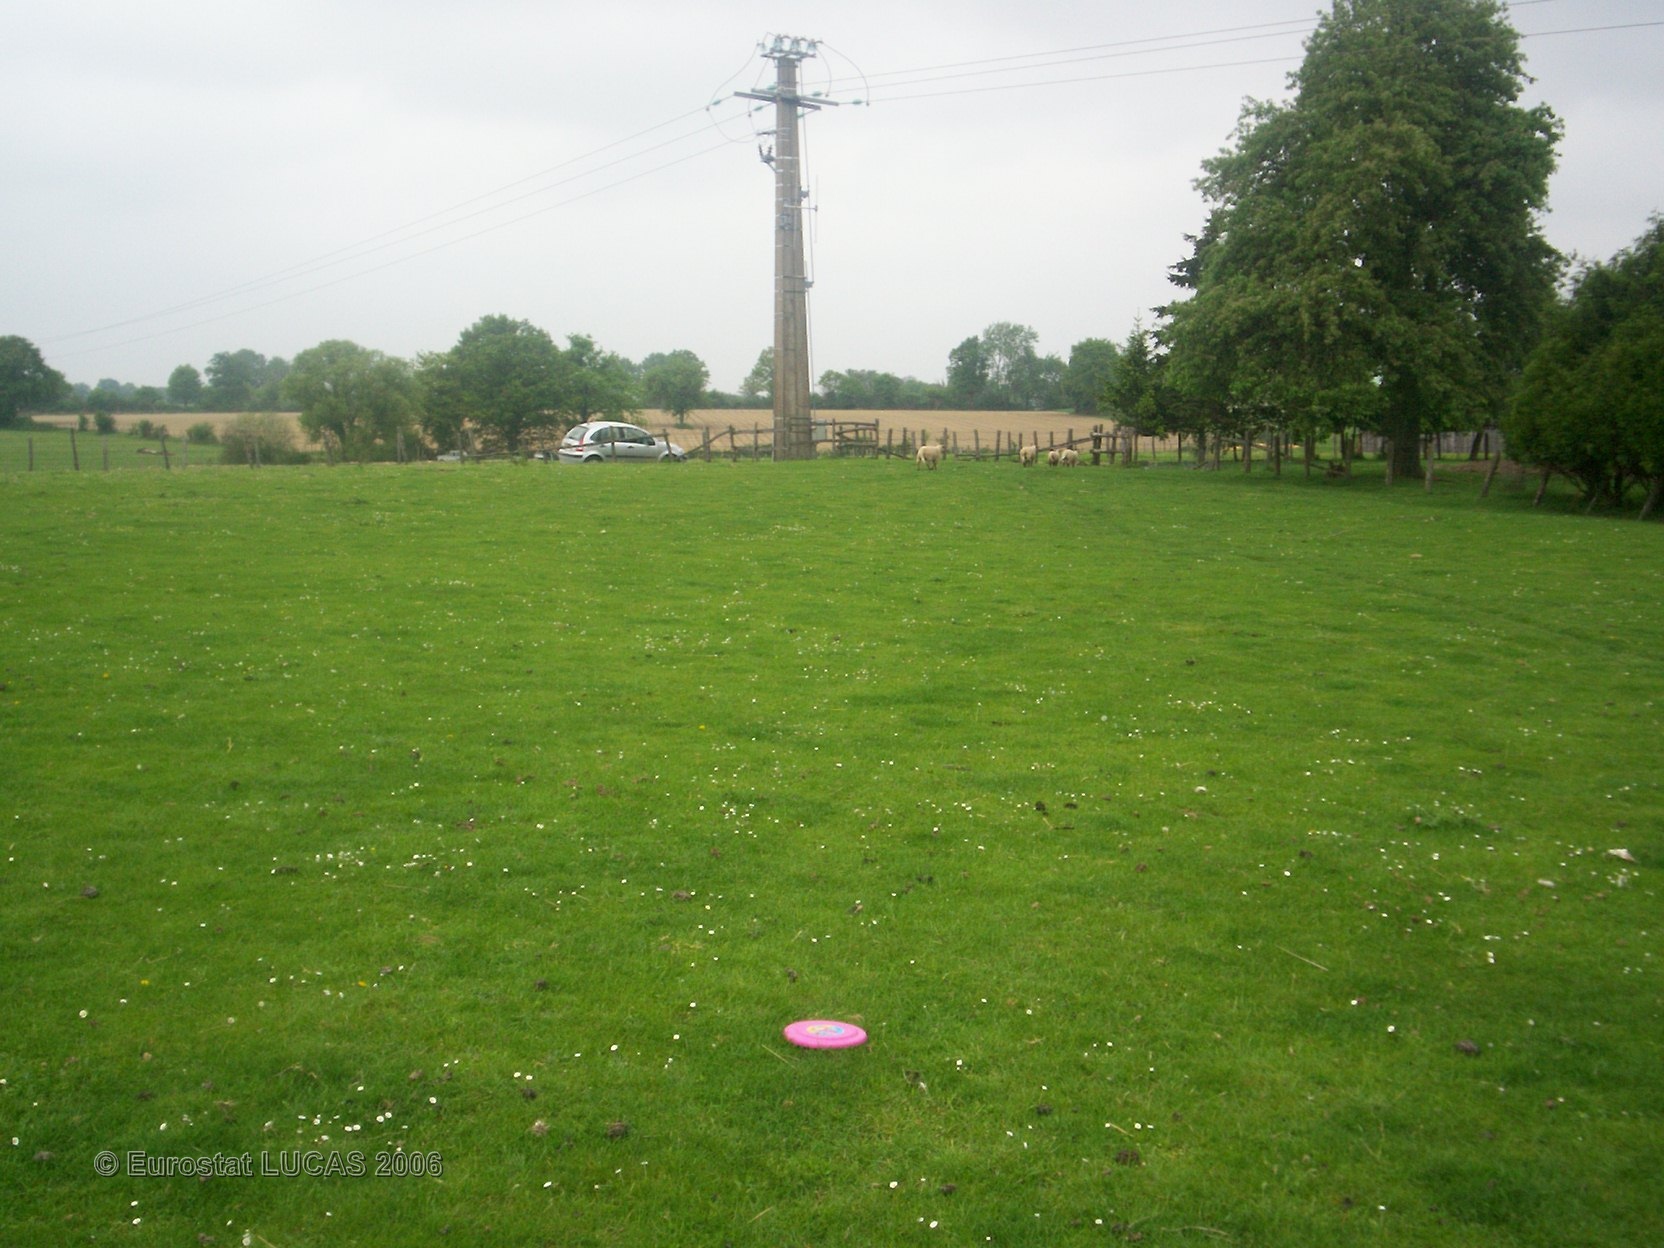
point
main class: Grassland
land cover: Grassland without tree/shrub cover
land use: Agriculture (excluding fallow land and kitchen gardens)
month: May
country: FR
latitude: 47.8443
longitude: 0.4493
